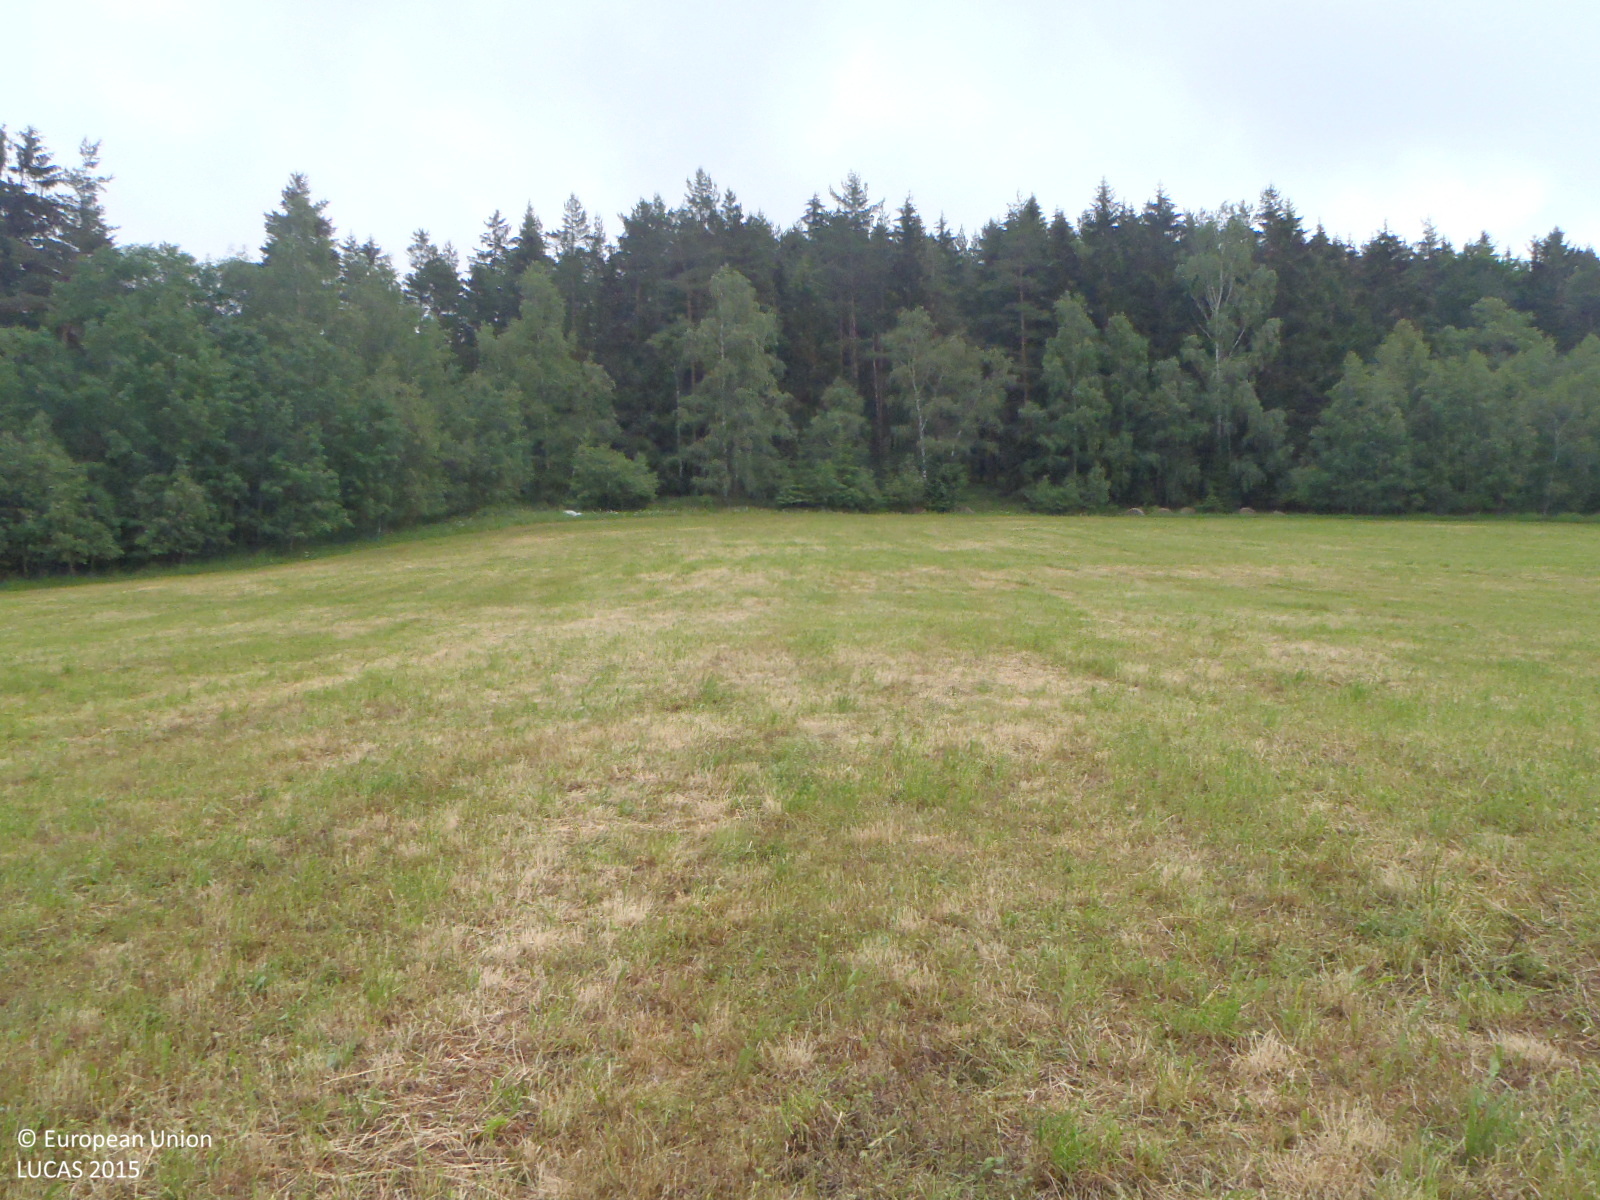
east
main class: Grassland
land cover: Grassland without tree/shrub cover
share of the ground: > 75 %
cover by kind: herbaceous plants 100 %
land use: Agriculture (excluding fallow land and kitchen gardens)
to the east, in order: Grassland without tree/shrub cover; Spruce dominated mixed woodland; Other coniferous woodland; Other mixed woodland
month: June
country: CZ
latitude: 48.6071
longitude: 14.3269
